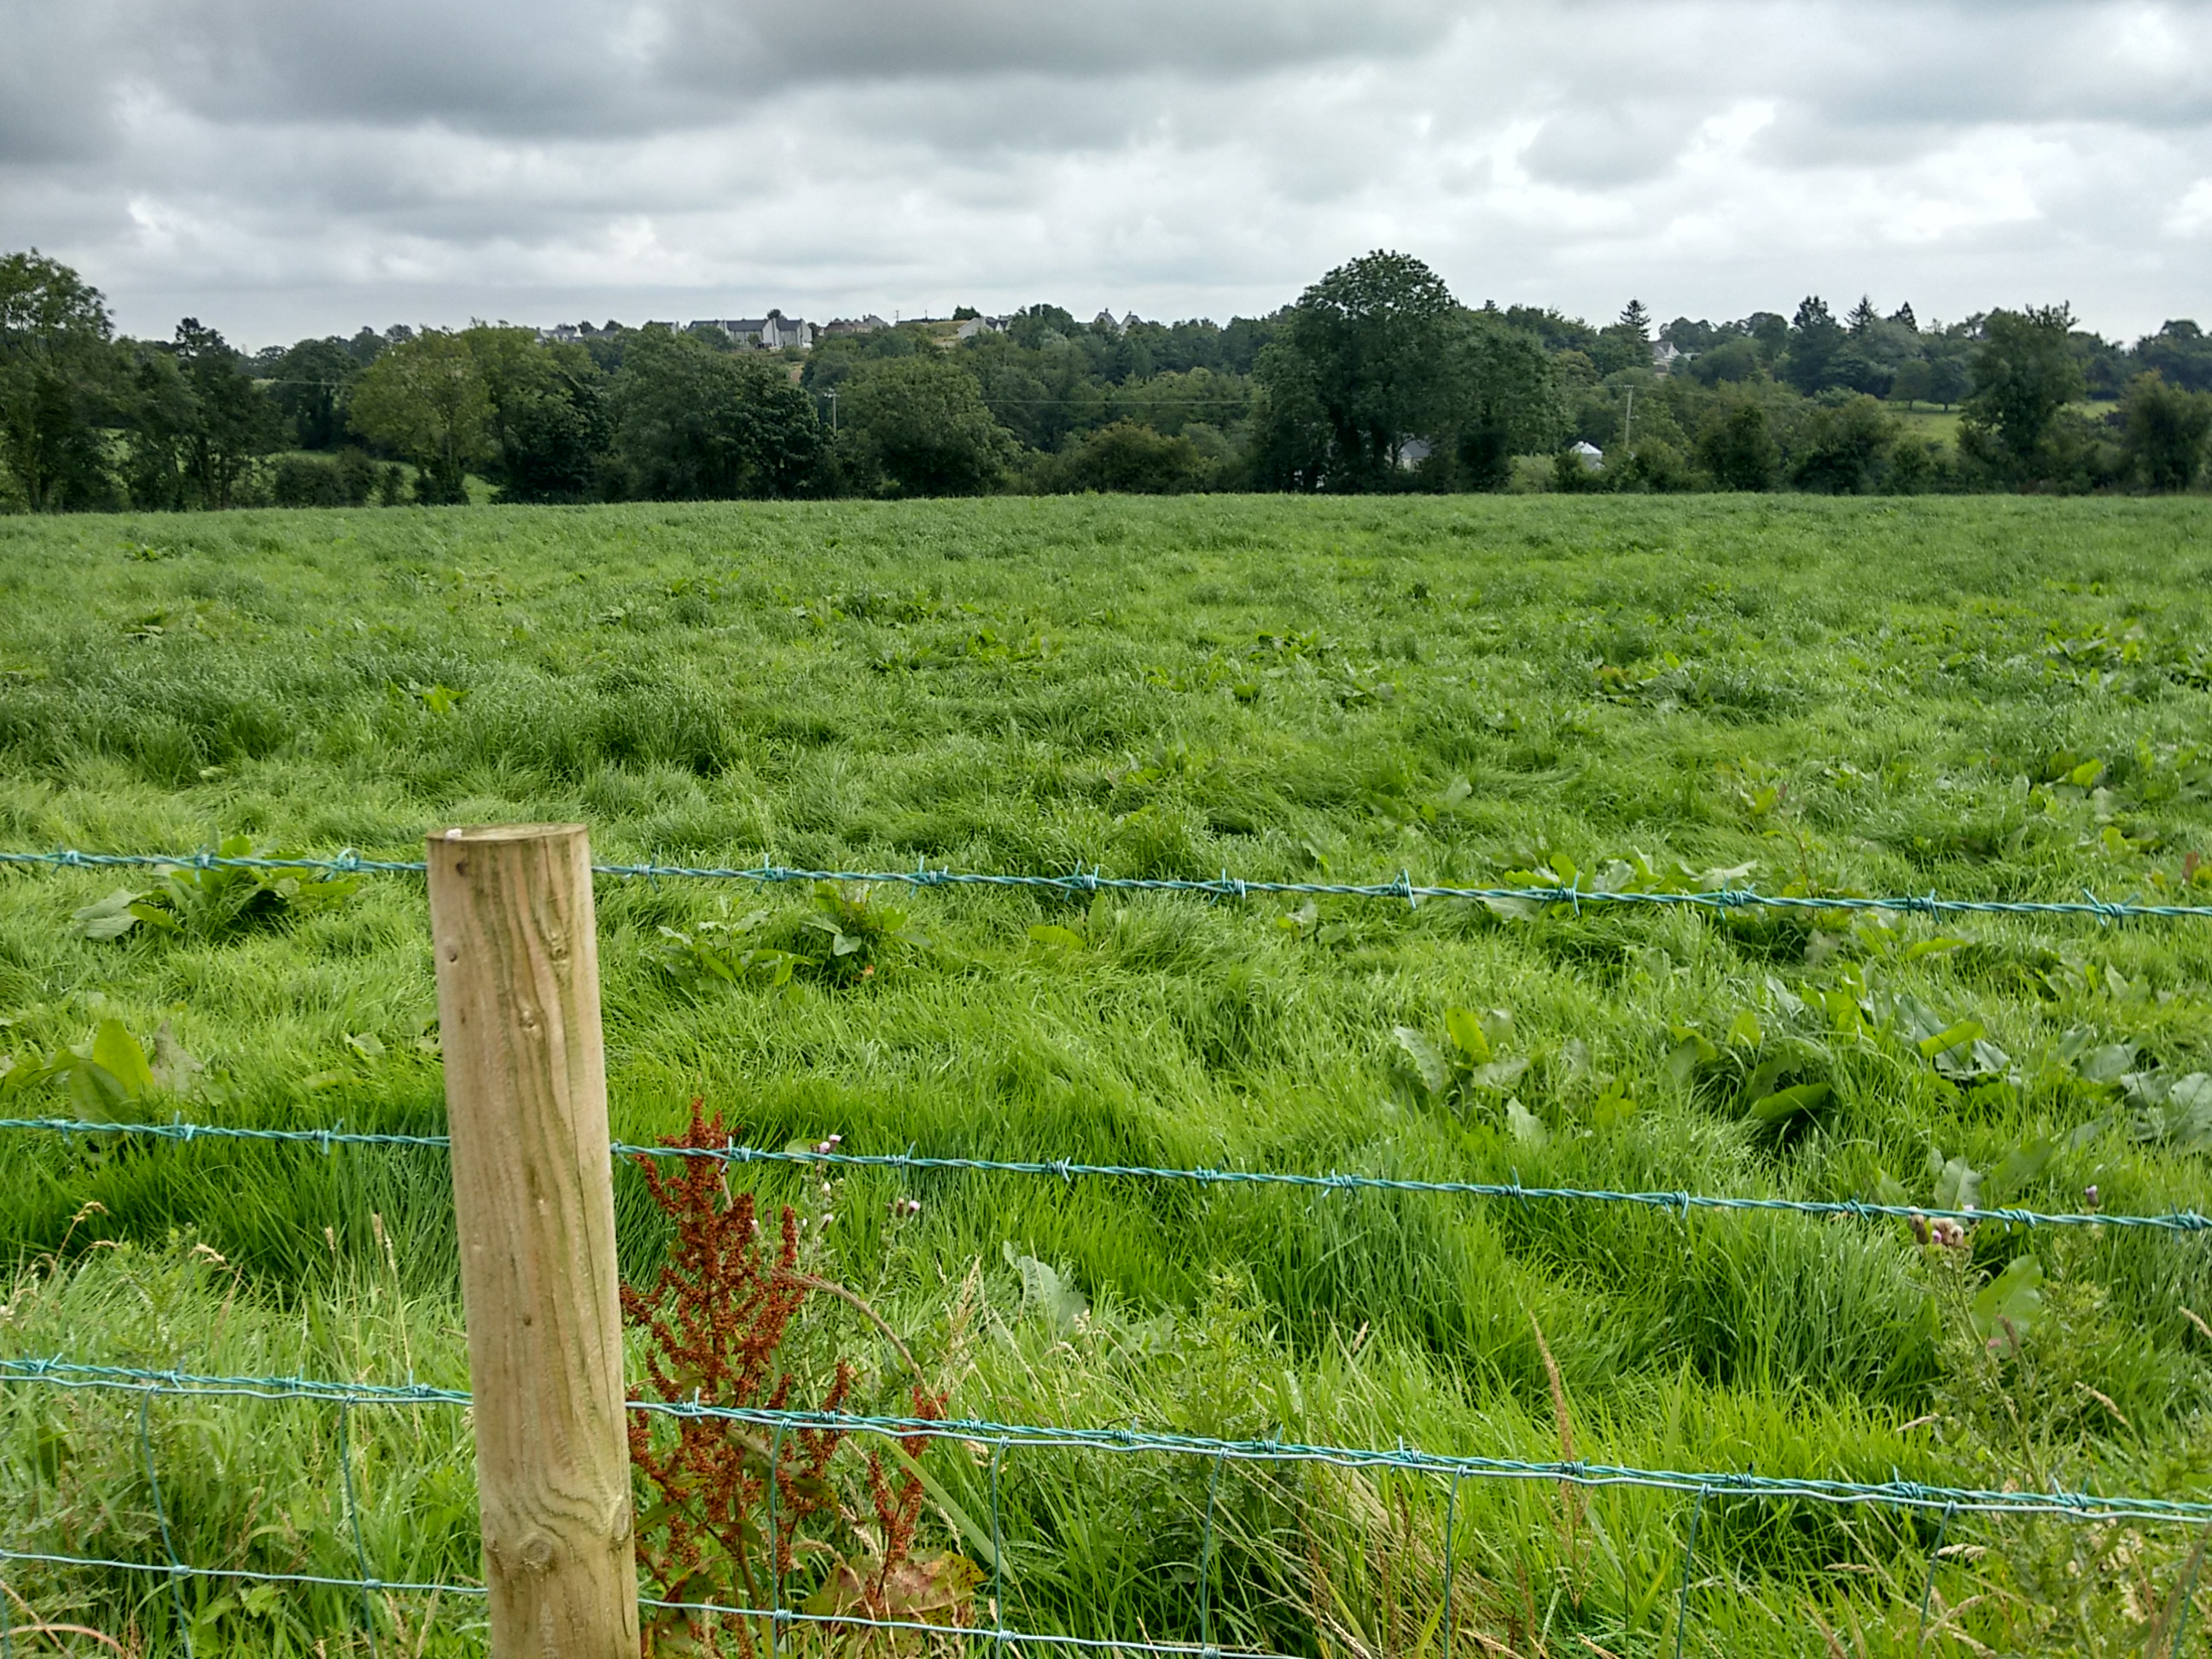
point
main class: Grassland
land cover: Grassland without tree/shrub cover
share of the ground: > 75 %
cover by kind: herbaceous plants 100 %
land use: Agriculture (excluding fallow land and kitchen gardens)
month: August
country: GB
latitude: 54.4109
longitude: -6.7574
